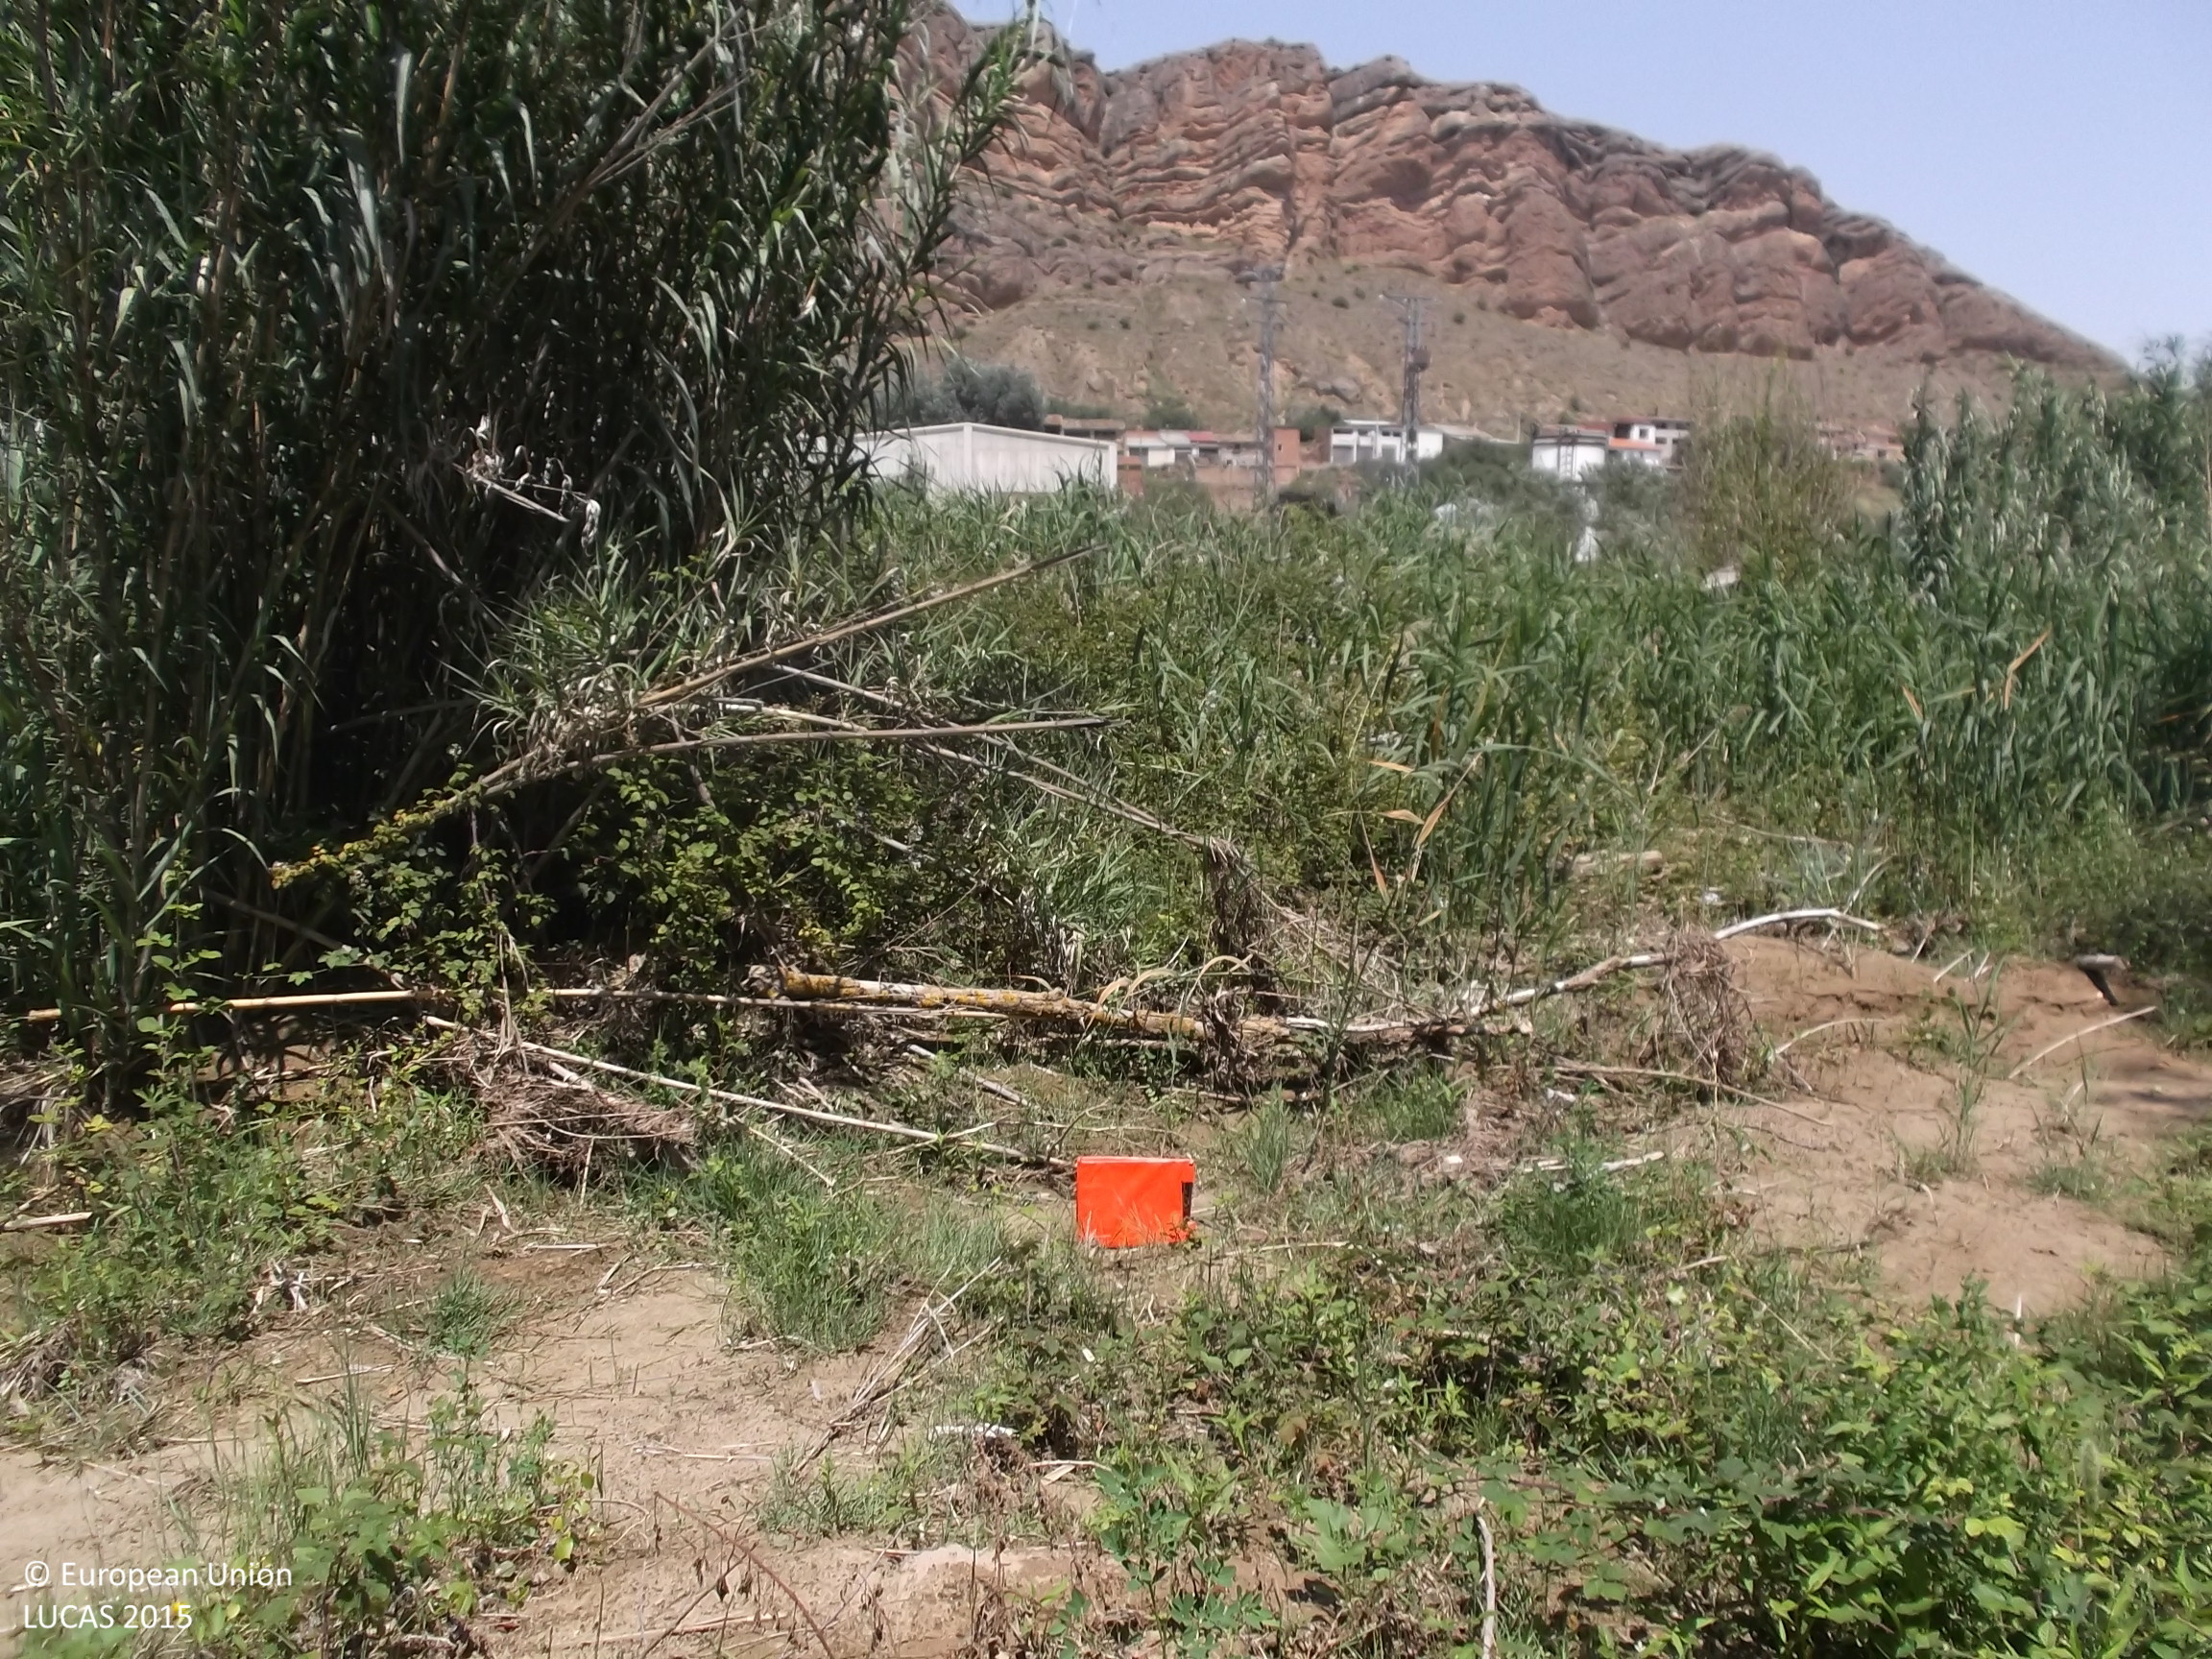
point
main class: Woodland
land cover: Broadleaved woodland
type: floodplain forest
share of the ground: 50 - 75 %
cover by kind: broadleaved forest trees 70 %, shrubs 15 %, herbaceous plants 10 %, unconsolidated bare surface 5 %
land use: Semi-natural and natural areas not in use
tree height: > 5 m
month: June
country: ES
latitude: 42.2243
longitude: -2.0443
